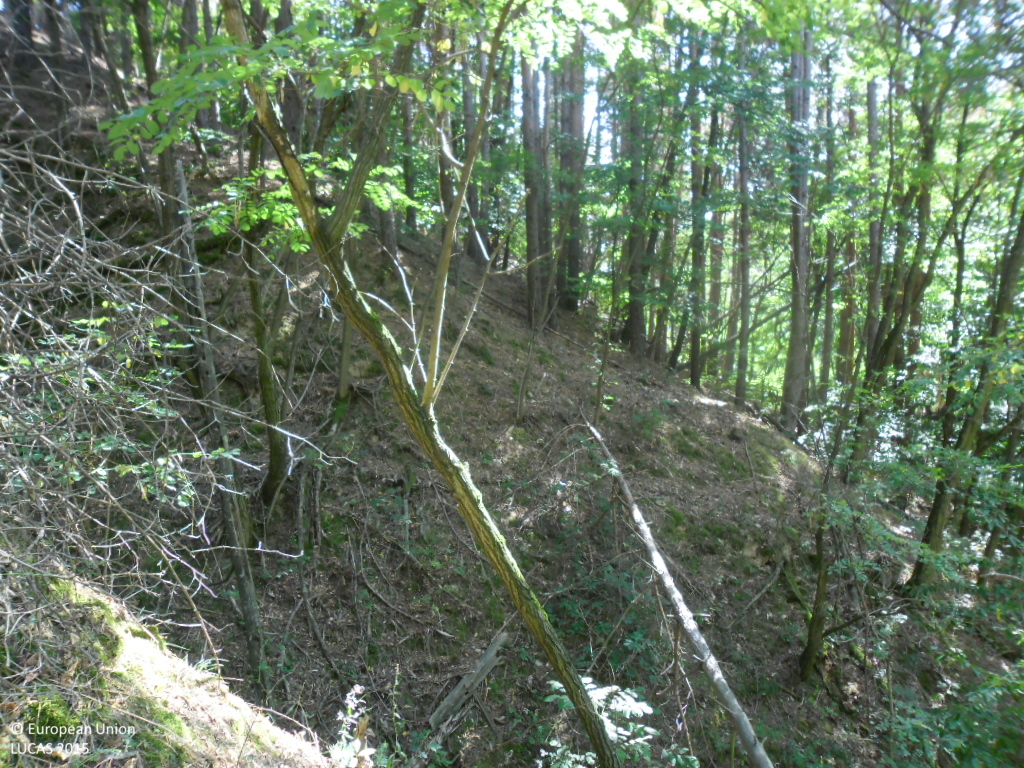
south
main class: Woodland
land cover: Pine dominated coniferous woodland
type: hemiboreal forest and nemoral coniferous forest and mixed broadleaved-coniferous forest
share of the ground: > 75 %
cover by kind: coniferous forest trees 100 %
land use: Forestry
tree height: < 5 m
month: September
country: BG
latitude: 41.8007
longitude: 23.2264
